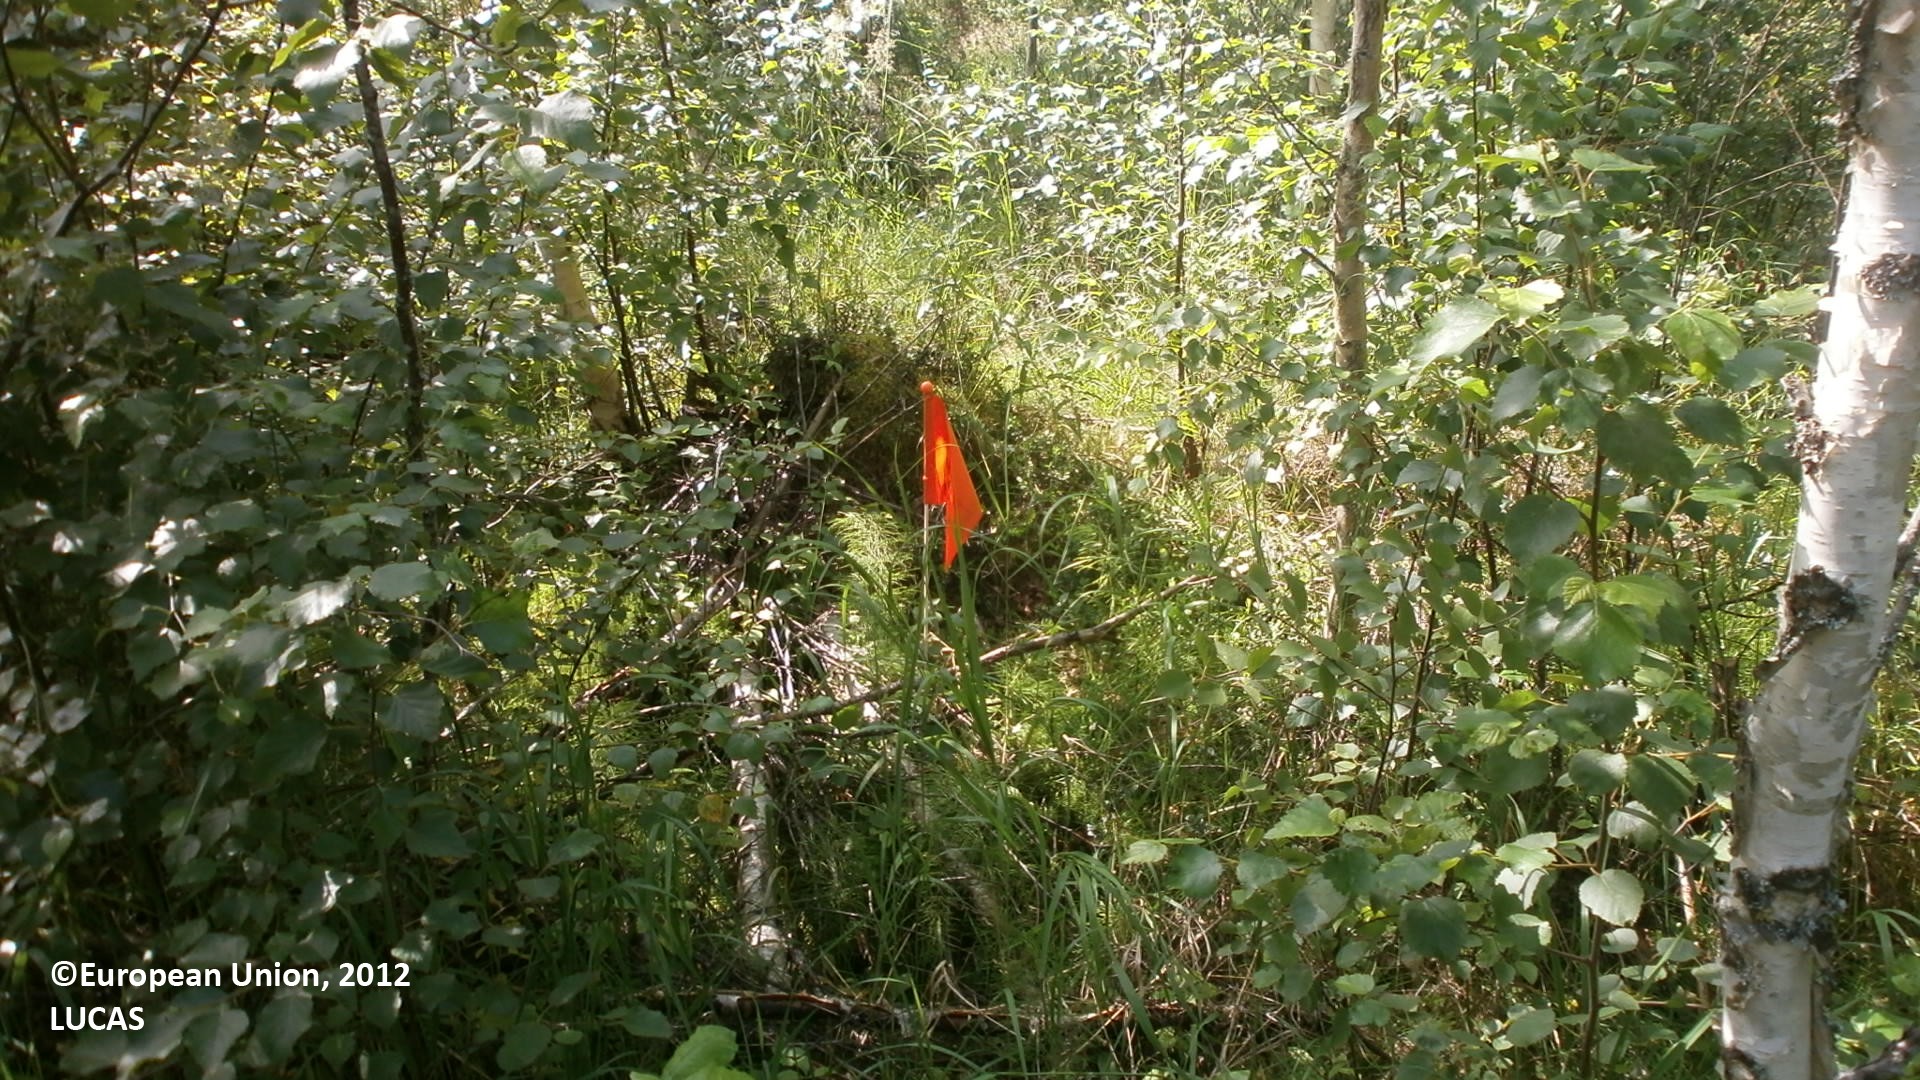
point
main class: Woodland
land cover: Other mixed woodland
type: boreal forest
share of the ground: > 75 %
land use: Forestry
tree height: > 5 m
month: July
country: FI
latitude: 64.3126
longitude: 24.1458
